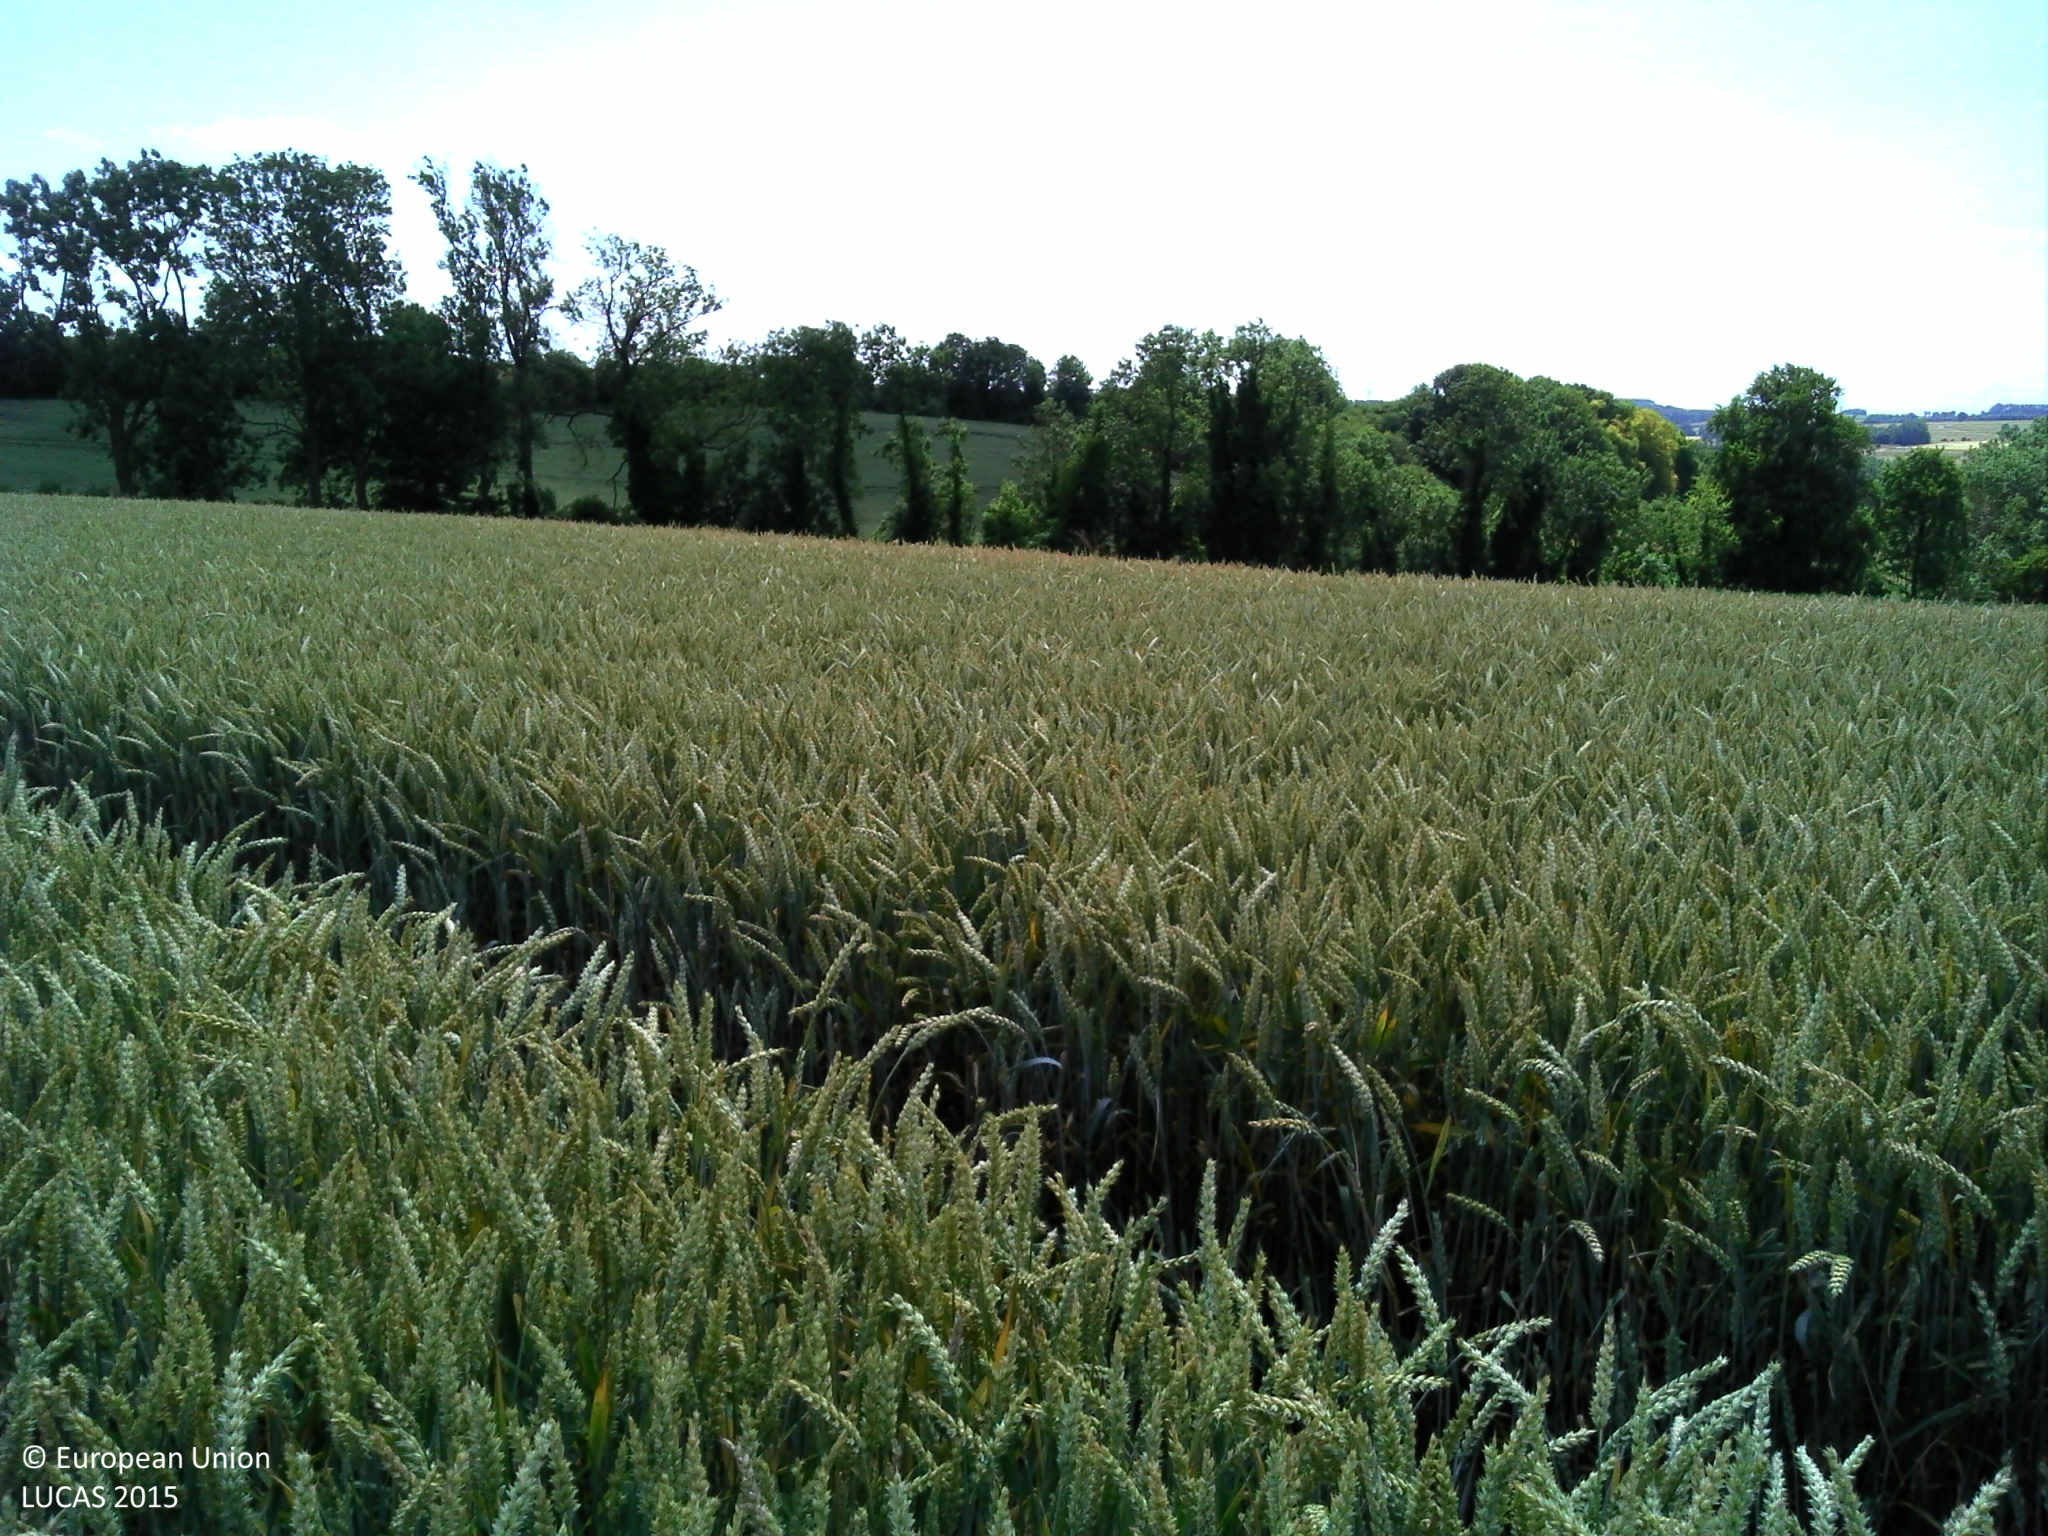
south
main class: Cropland
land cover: Common wheat
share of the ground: > 75 %
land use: Agriculture (excluding fallow land and kitchen gardens)
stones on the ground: 10 - 25 %
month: July
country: FR
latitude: 50.3297
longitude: 2.1608
